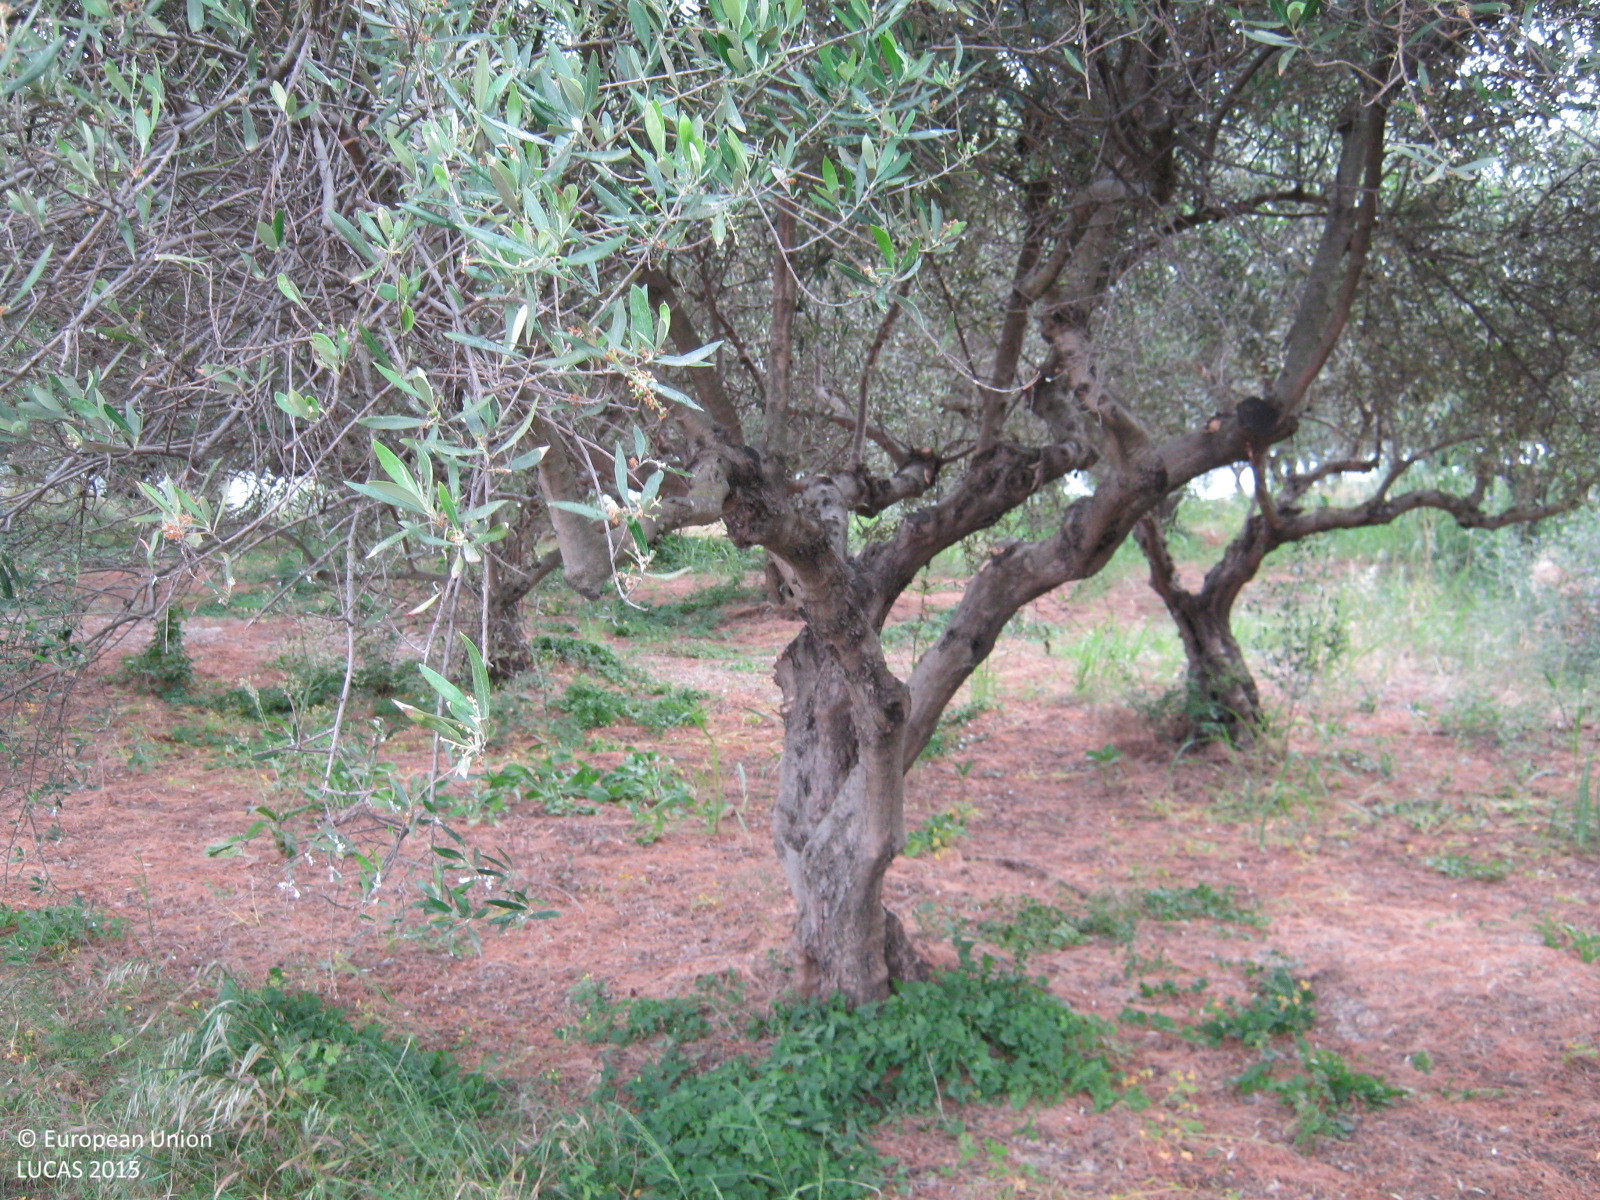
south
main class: Cropland
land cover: Olive groves
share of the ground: > 75 %
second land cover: Spontaneously vegetated surfaces
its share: > 75 %
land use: Agriculture (excluding fallow land and kitchen gardens)
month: May
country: GR
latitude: 35.4867
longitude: 23.7949
